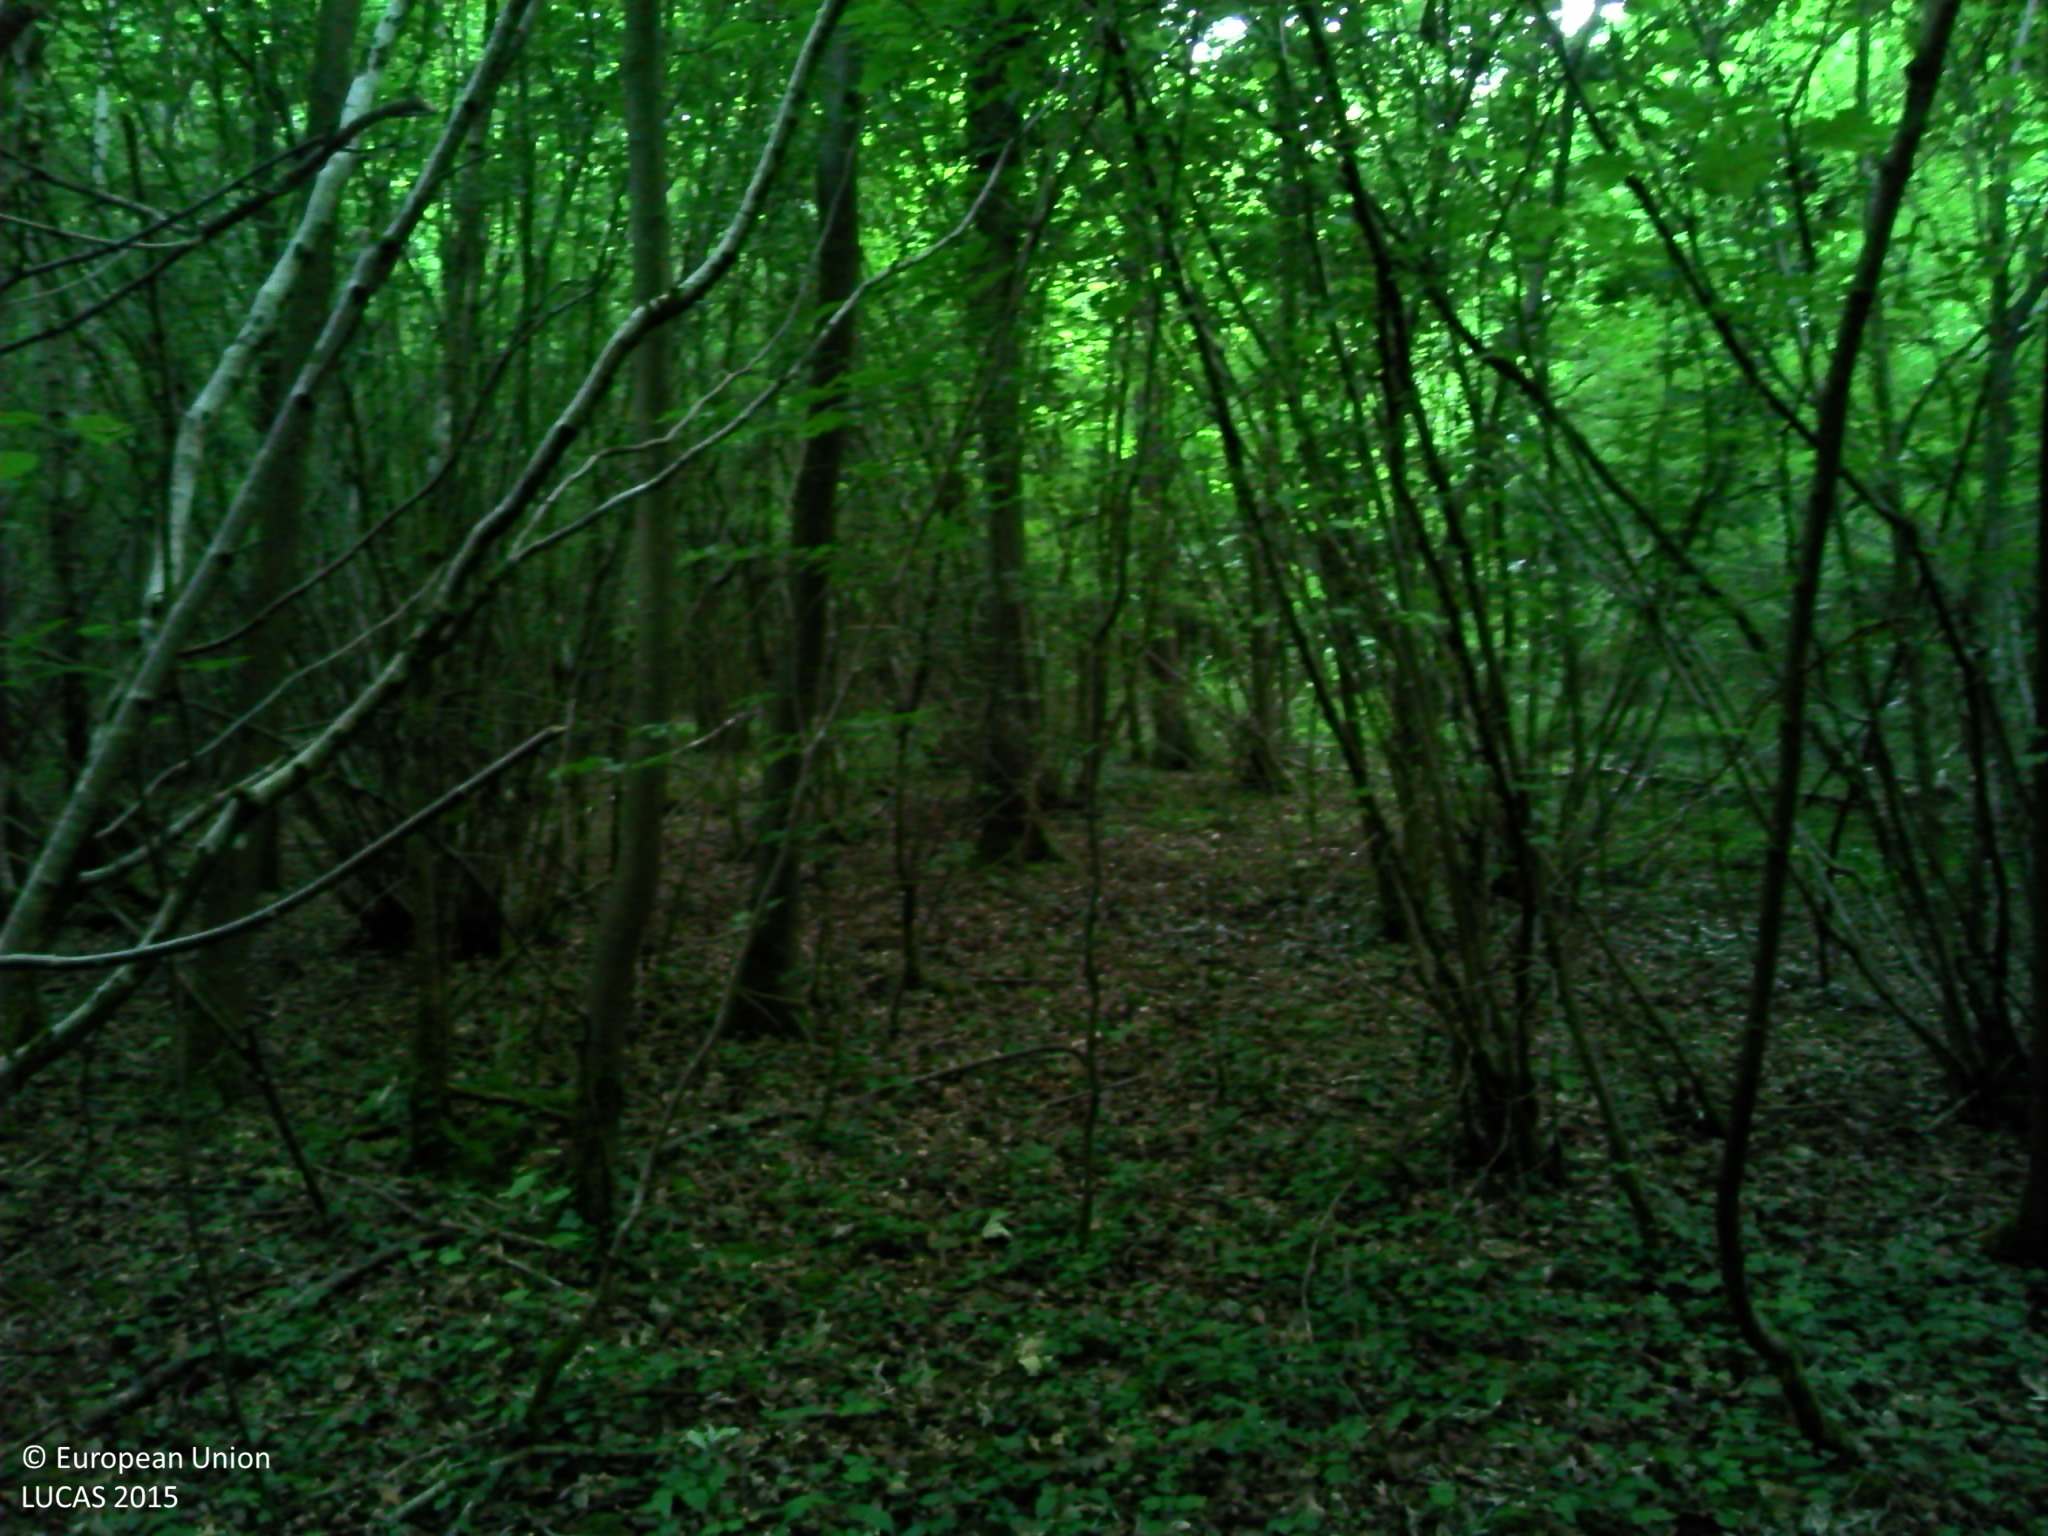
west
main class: Woodland
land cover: Broadleaved woodland
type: mesophytic deciduous forest
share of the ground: > 75 %
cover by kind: broadleaved forest trees 80 %, herbaceous plants 15 %, consolidated bare surface 5 %
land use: Forestry
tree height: > 5 m
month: June
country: FR
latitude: 49.2287
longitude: 1.2049
